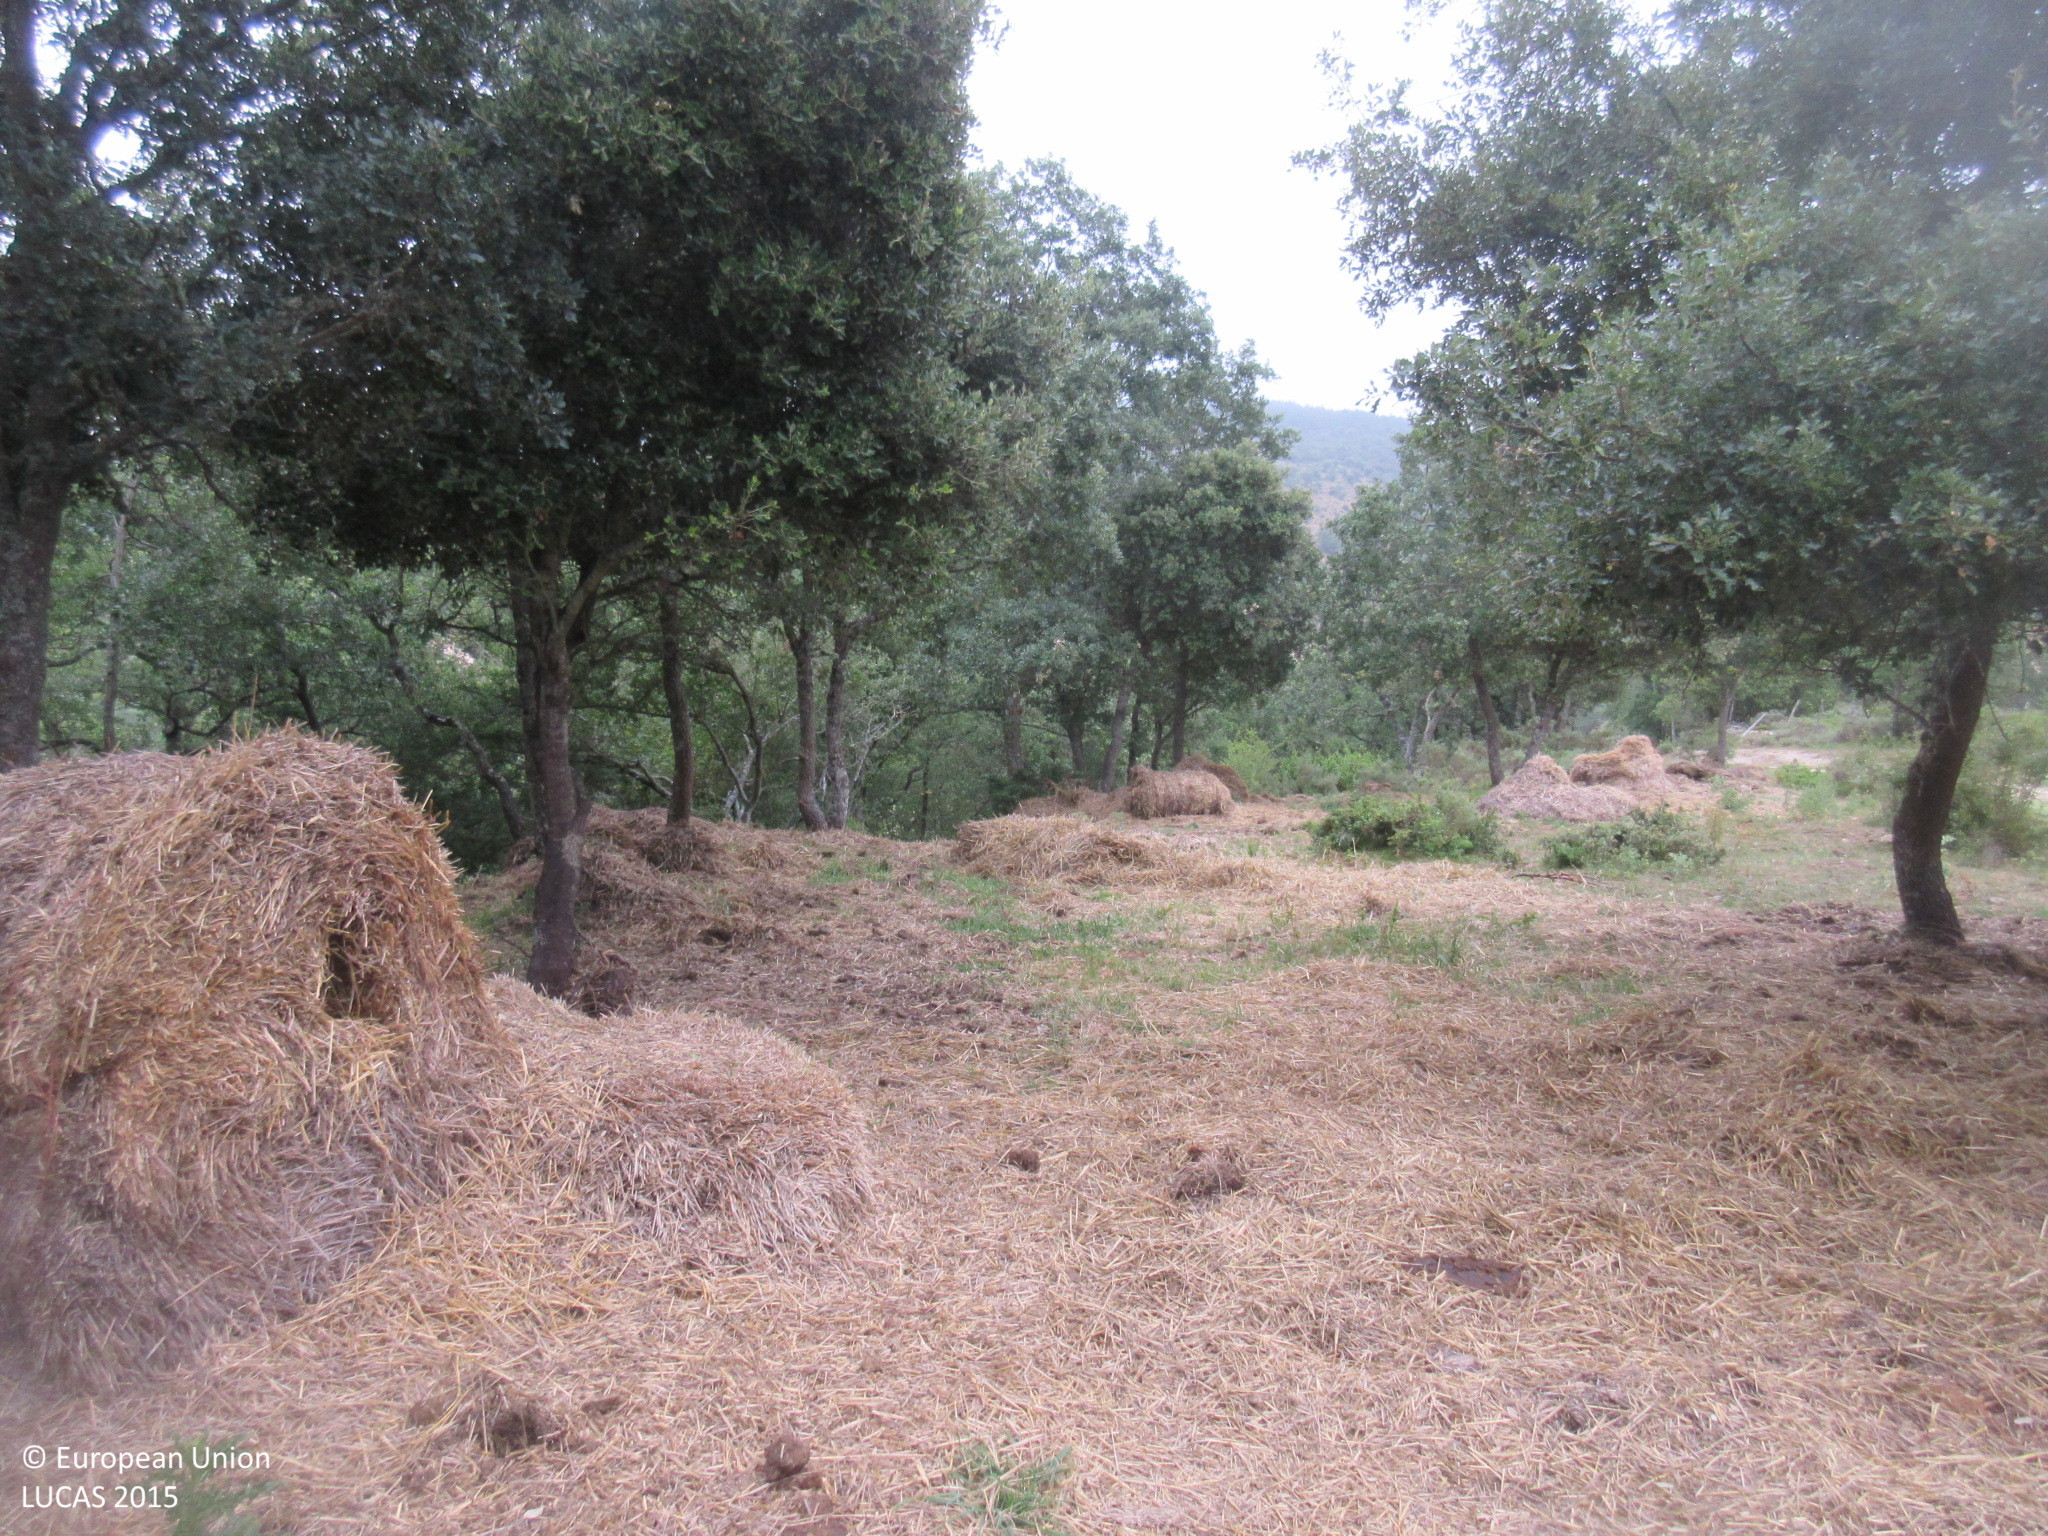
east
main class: Woodland
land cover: Broadleaved woodland
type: broadleaved evergreen forest
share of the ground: > 75 %
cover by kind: broadleaved forest trees 75 %, herbaceous plants 20 %, shrubs 5 %
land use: Agriculture (excluding fallow land and kitchen gardens)
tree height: > 5 m
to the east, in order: Broadleaved woodland; Tracks; Electric lines; Broadleaved woodland; Grassland with sparse tree/shrub cover; Tracks; Grassland without tree/shrub cover
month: July
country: ES
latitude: 43.0185
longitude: -3.5505
